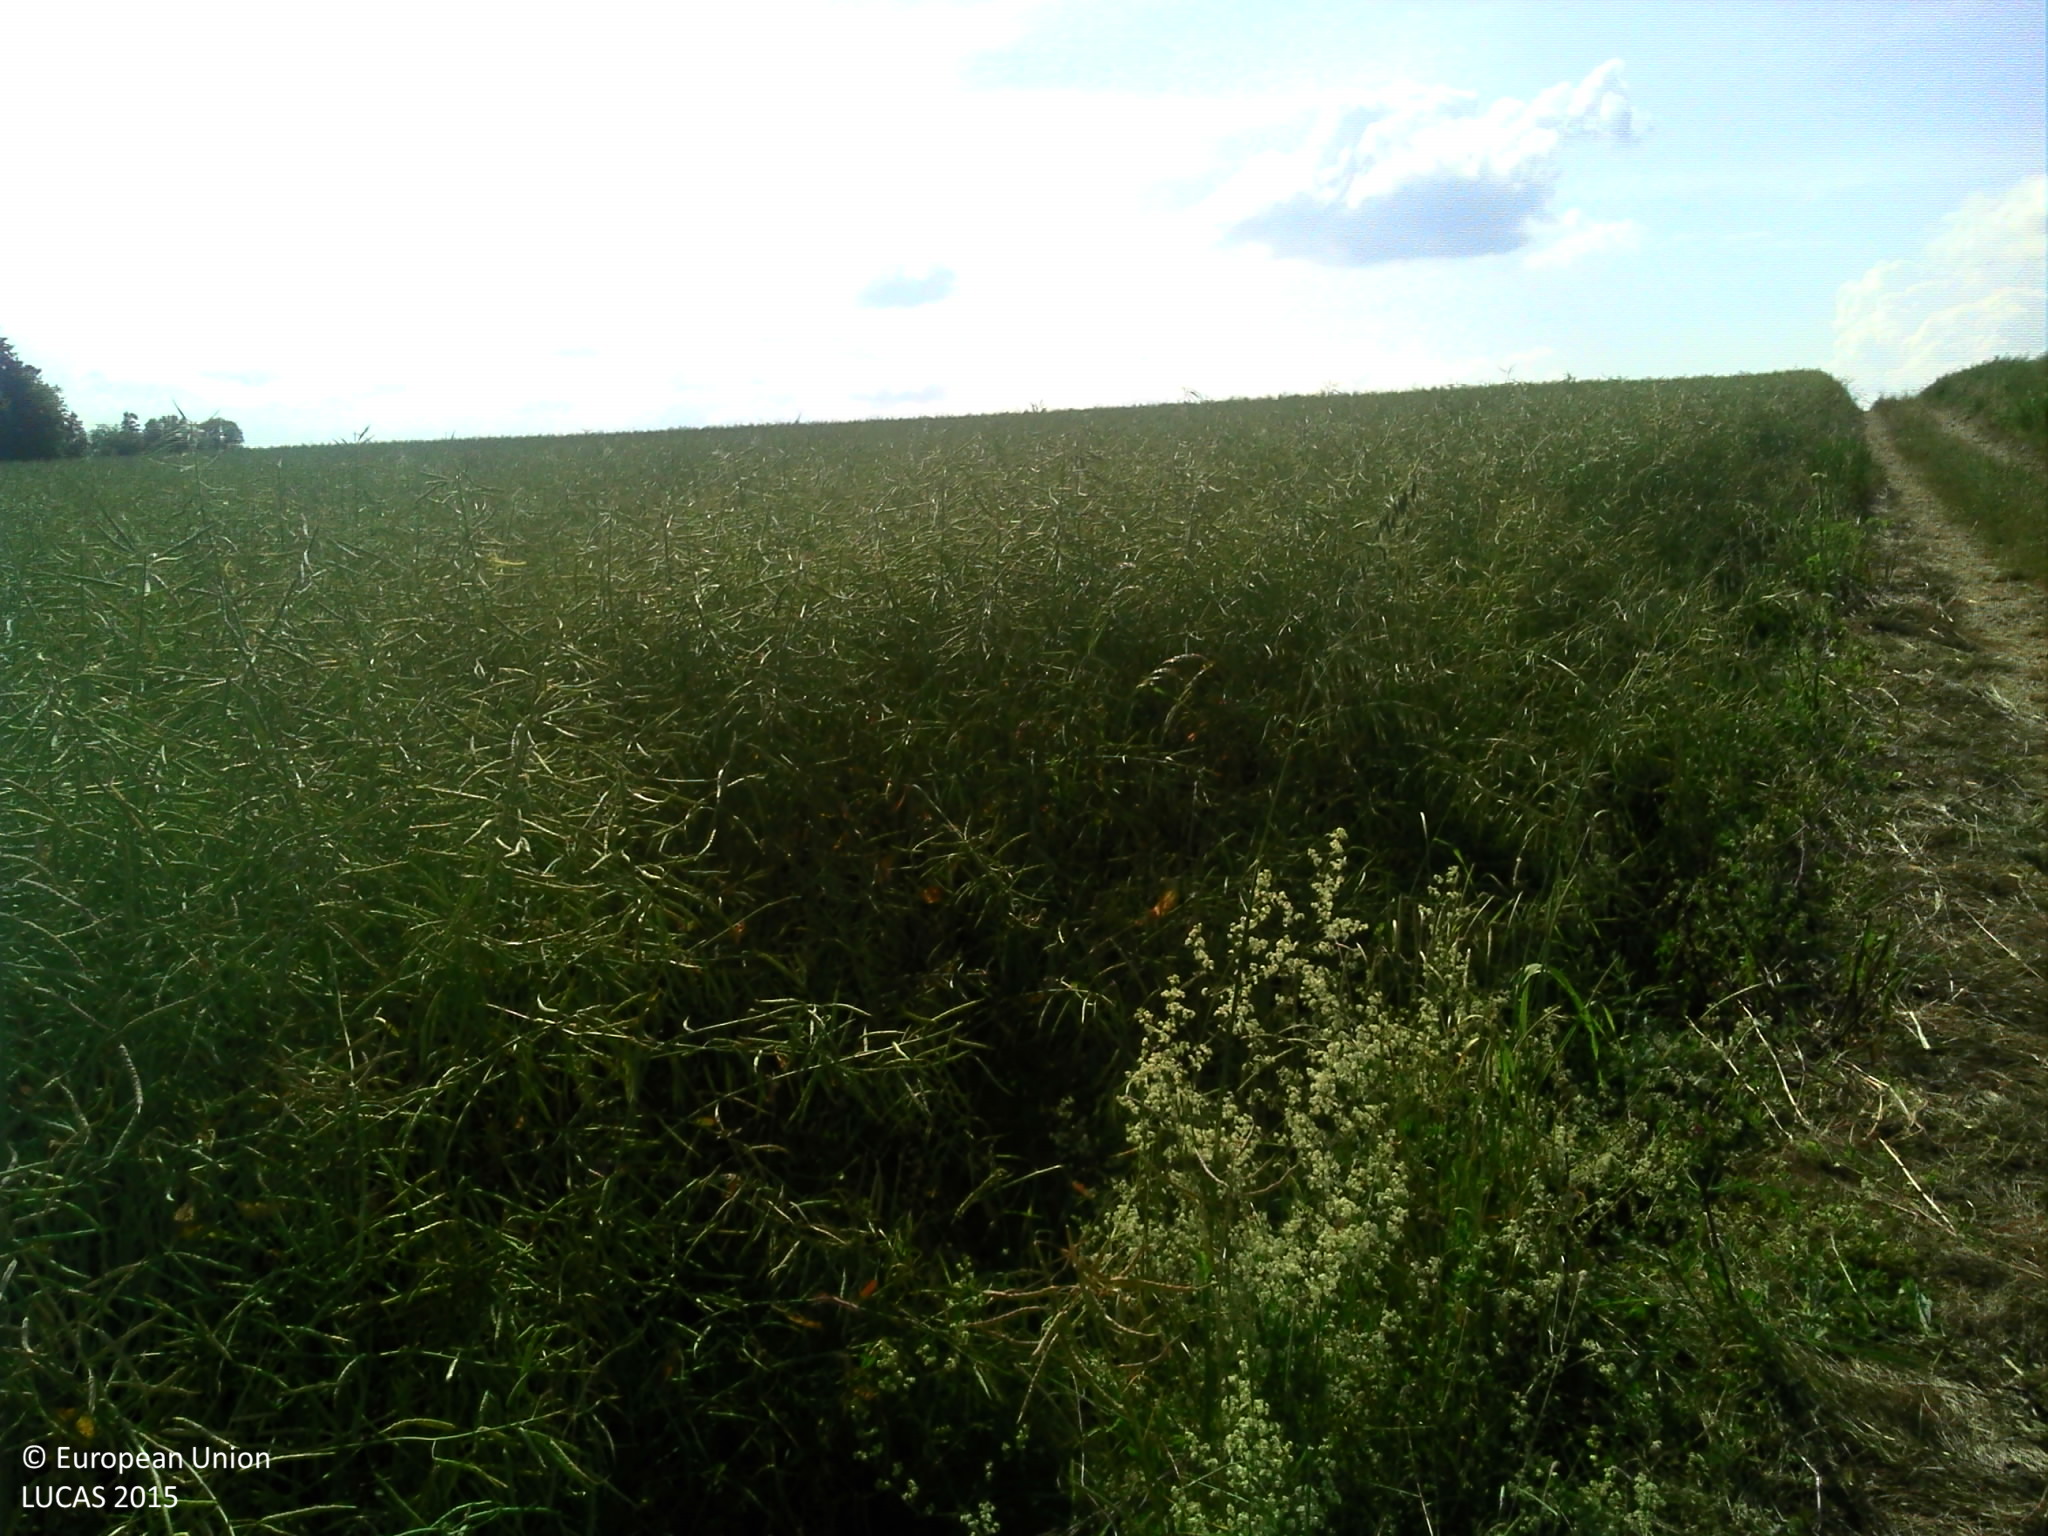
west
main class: Cropland
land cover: Rape and turnip rape
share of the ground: > 75 %
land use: Agriculture (excluding fallow land and kitchen gardens)
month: June
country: FR
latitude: 48.3034
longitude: 4.8889
